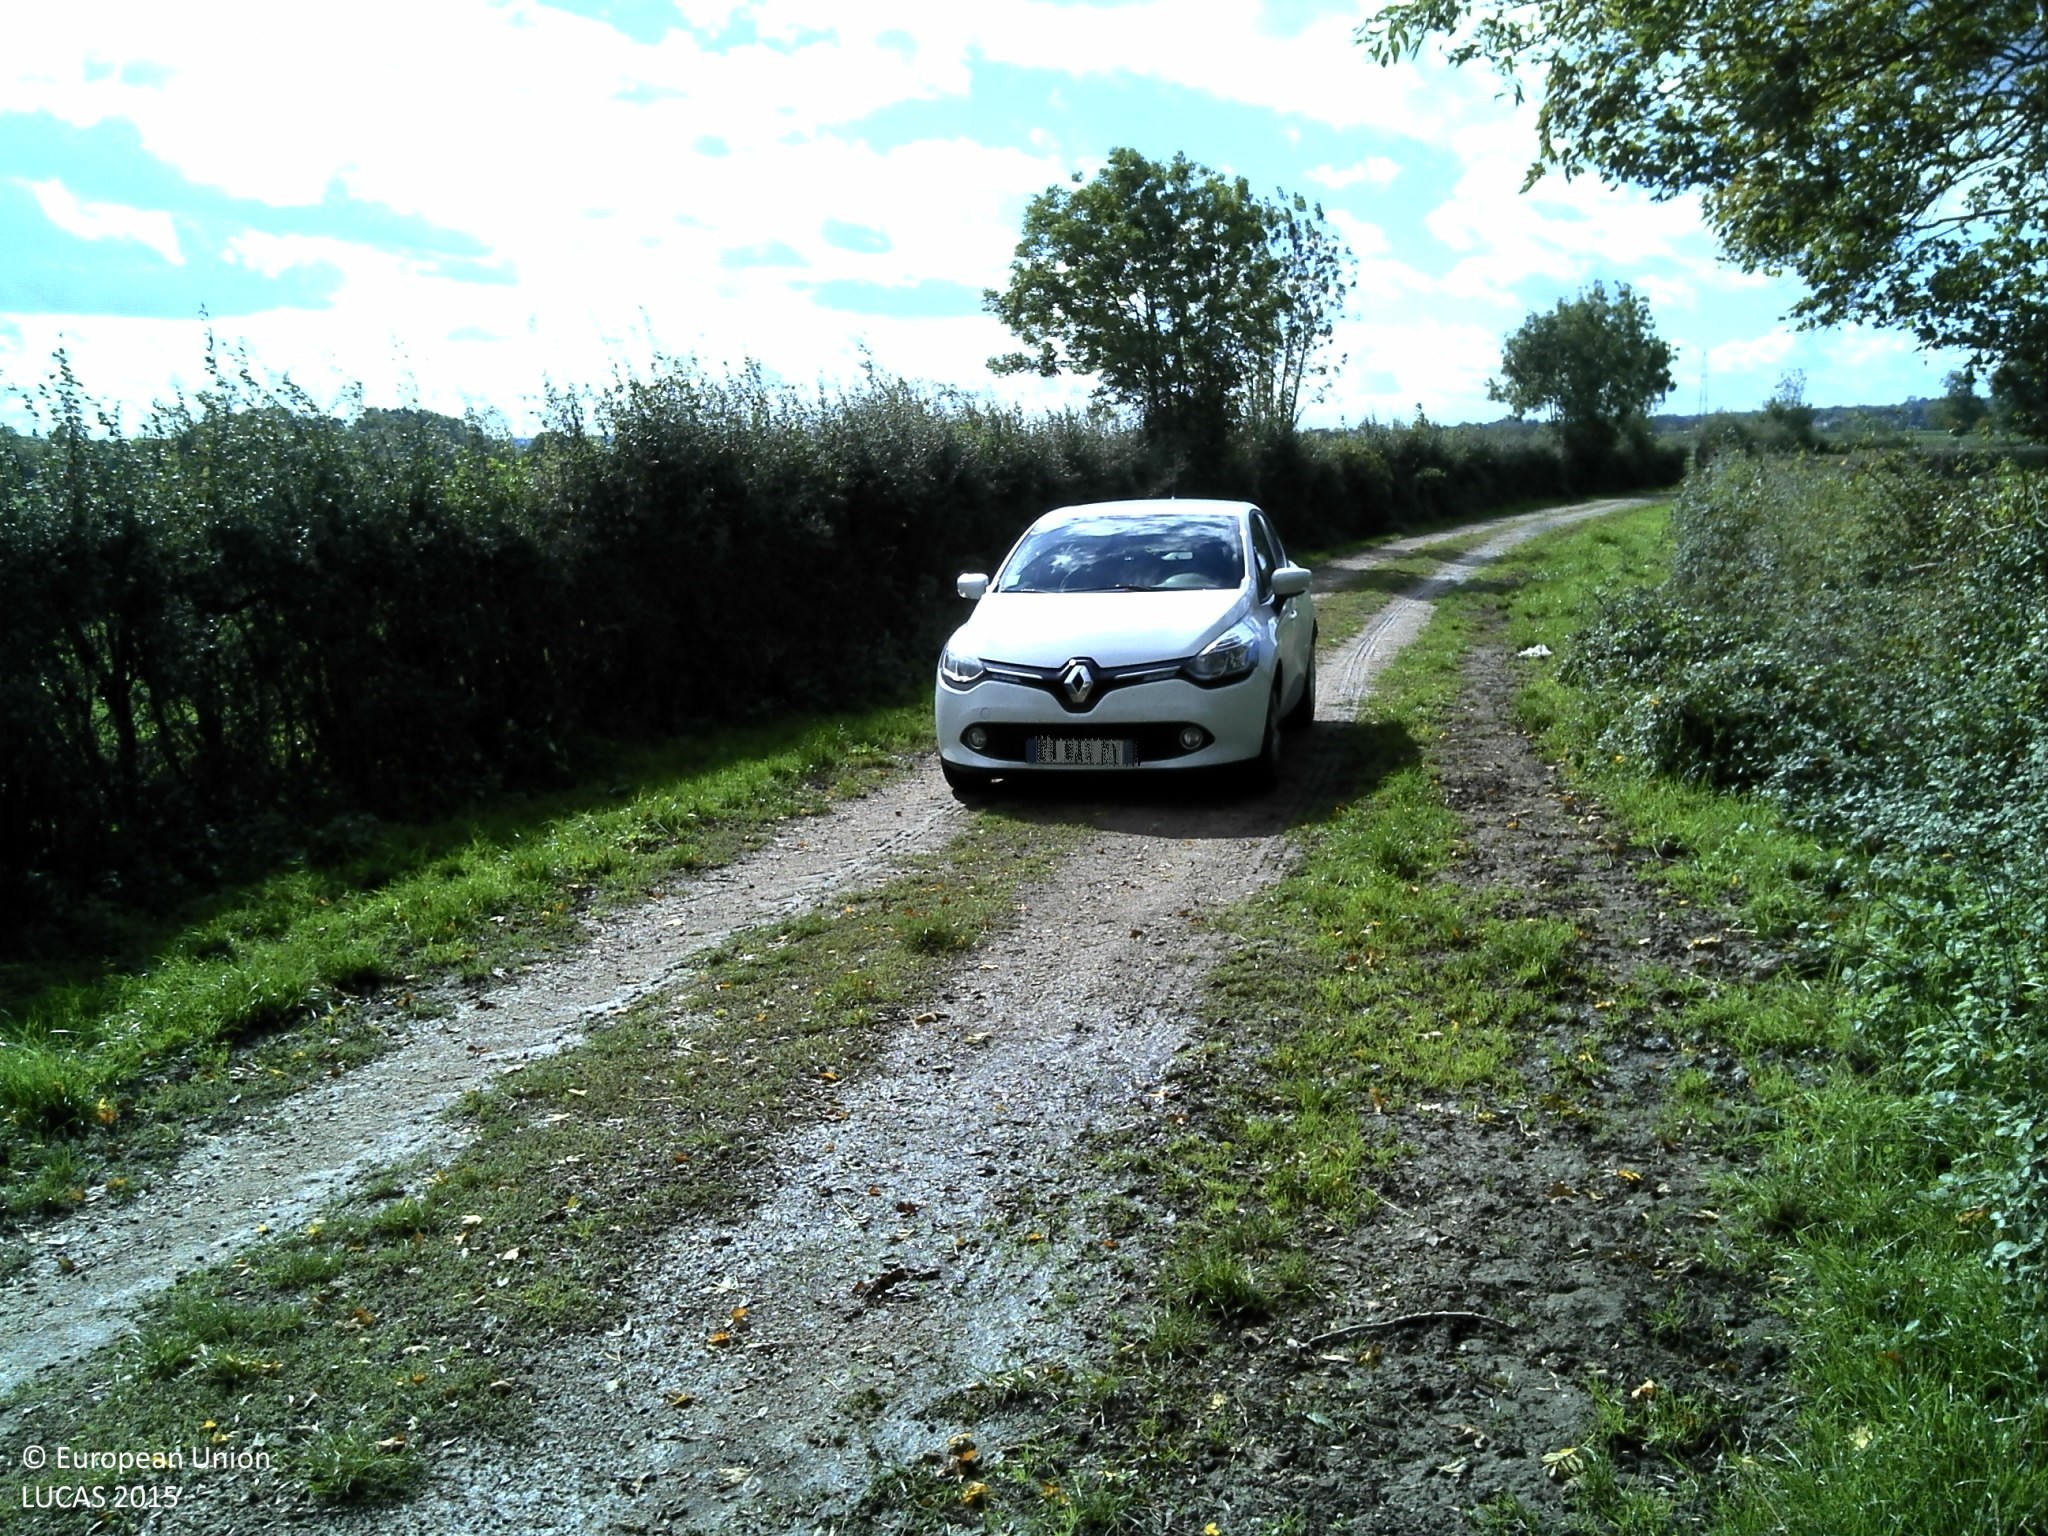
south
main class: Grassland
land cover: Grassland without tree/shrub cover
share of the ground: > 75 %
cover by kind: herbaceous plants 100 %
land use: Agriculture (excluding fallow land and kitchen gardens)
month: October
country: FR
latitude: 46.6194
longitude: 4.0583
